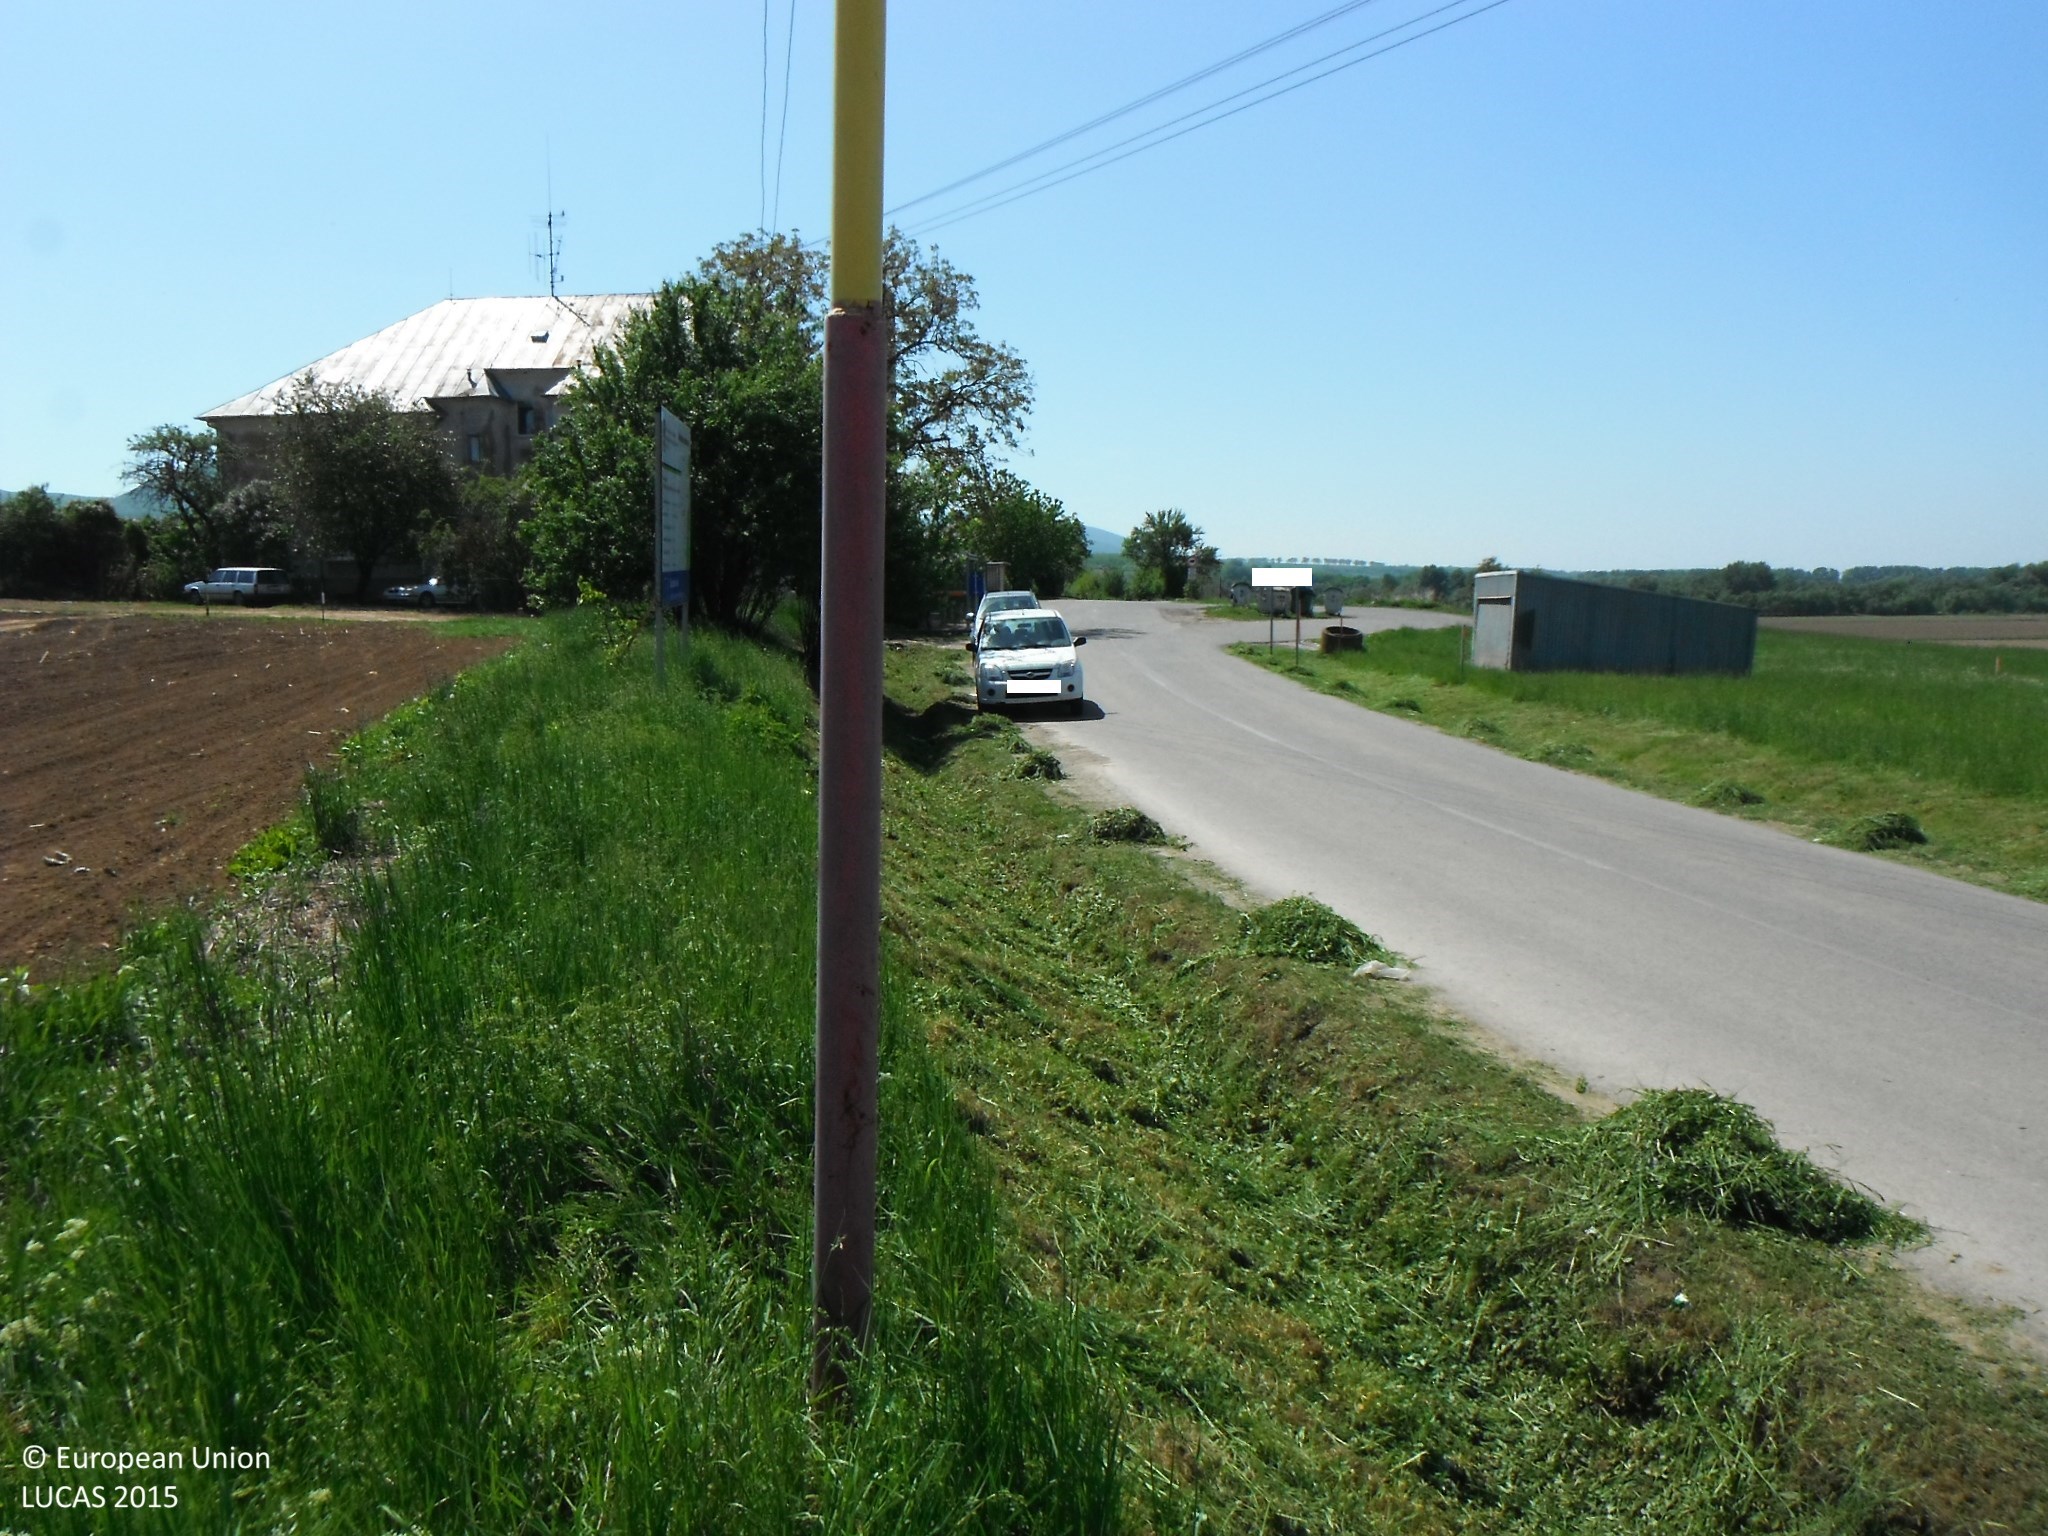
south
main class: Cropland
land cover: Maize
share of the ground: < 10 %
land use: Agriculture (excluding fallow land and kitchen gardens)
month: May
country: SK
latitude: 48.5636
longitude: 21.3328
